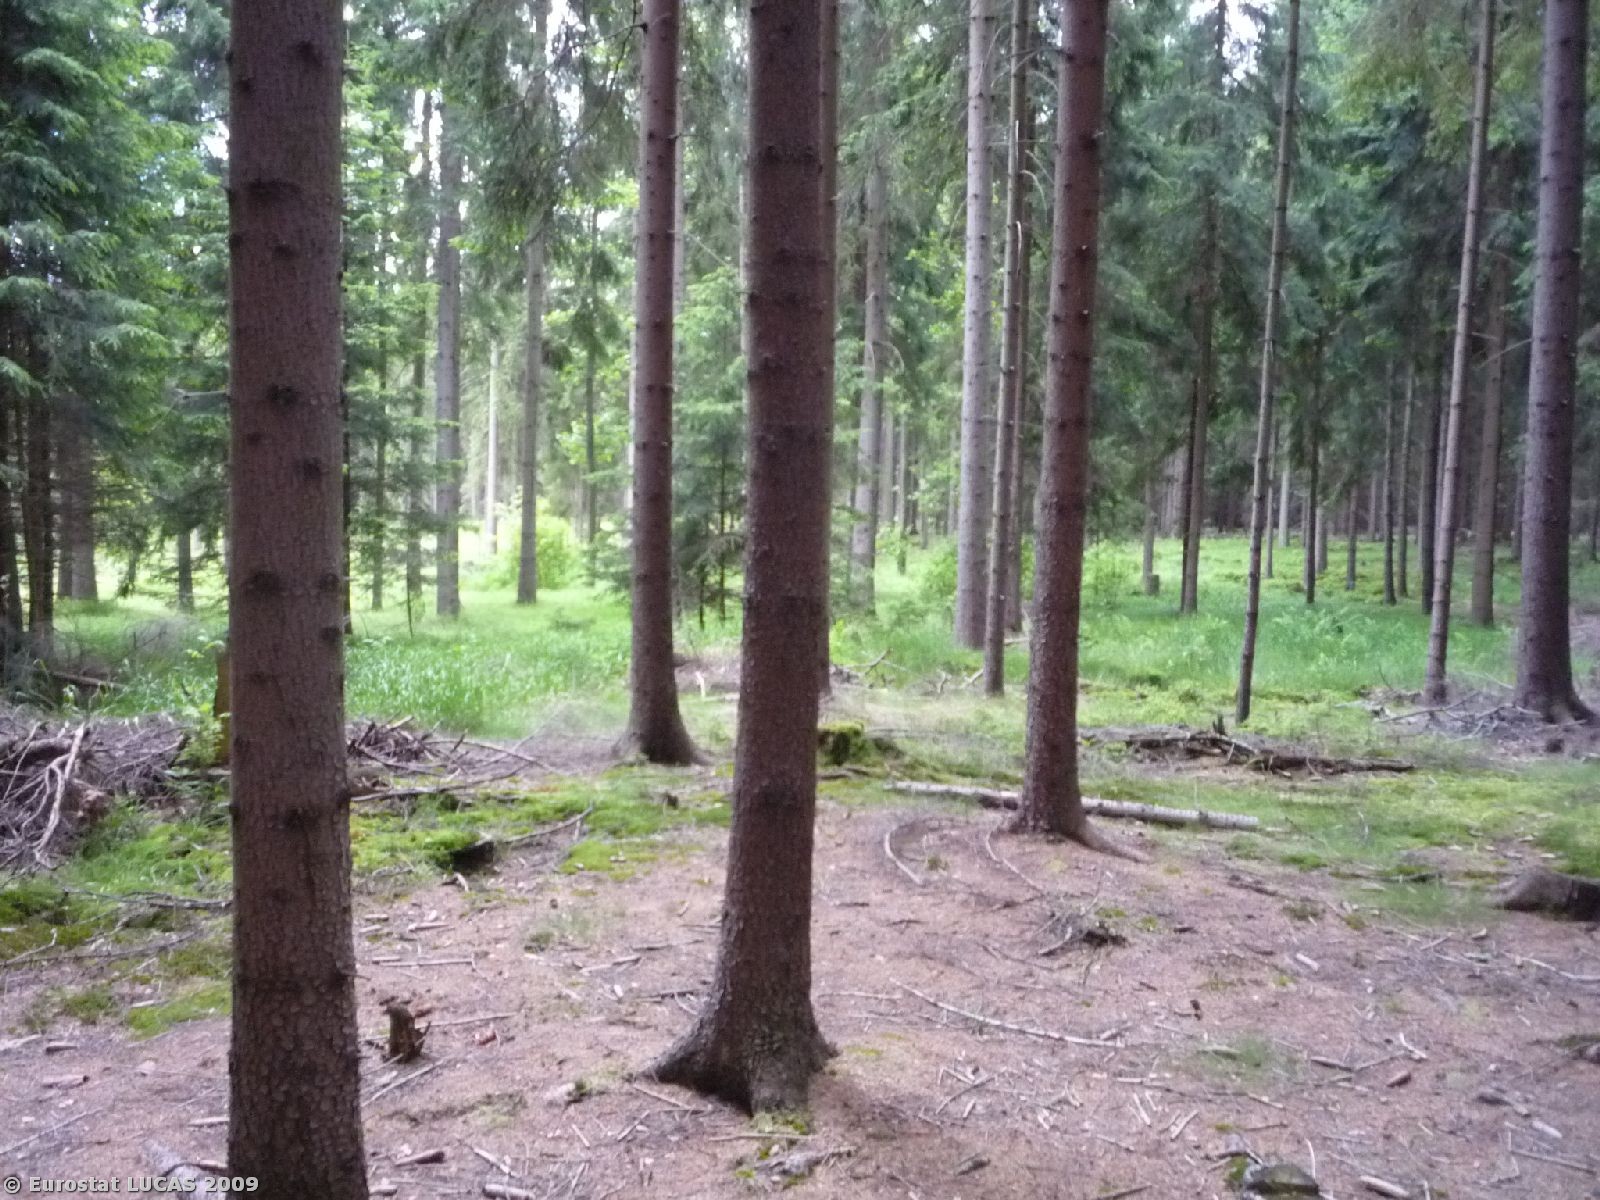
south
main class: Woodland
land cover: Coniferous woodland
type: hemiboreal forest and nemoral coniferous forest and mixed broadleaved-coniferous forest
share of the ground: > 75 %
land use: Forestry
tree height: > 5 m
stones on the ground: < 10 %
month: June
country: CZ
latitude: 50.5896
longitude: 15.5555
